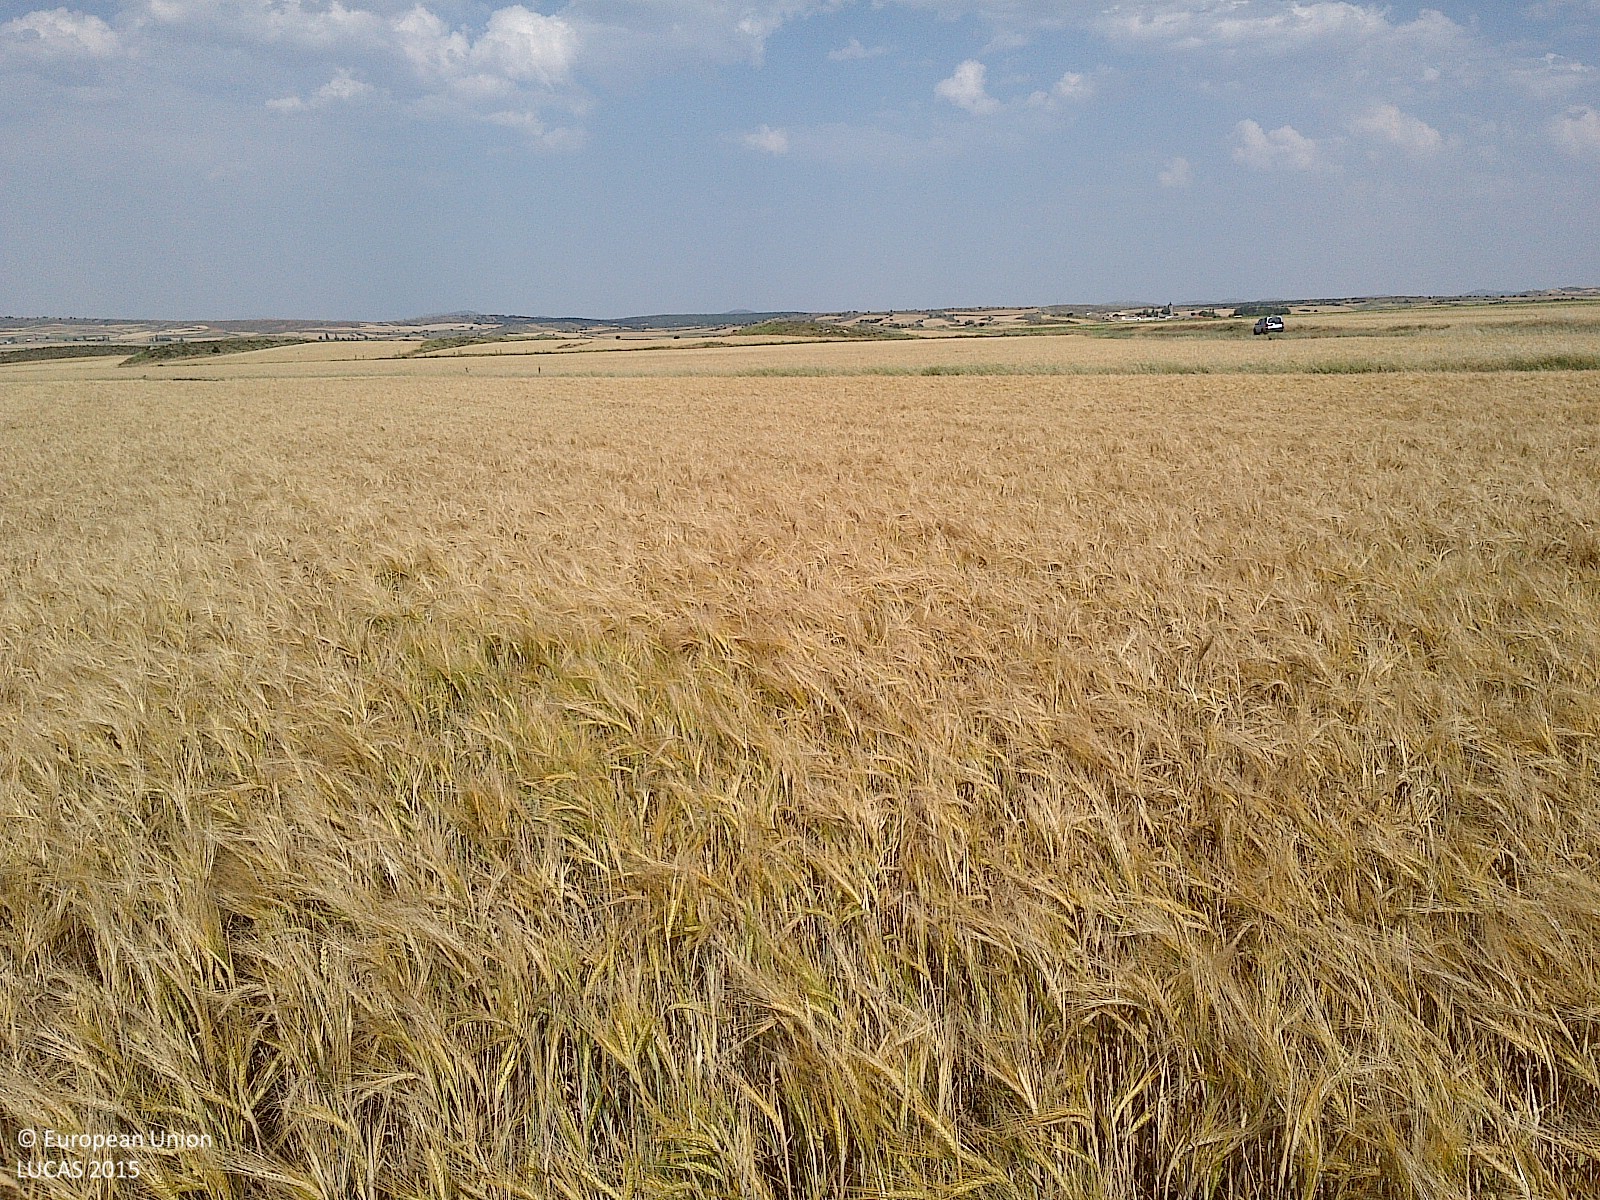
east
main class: Cropland
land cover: Barley
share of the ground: > 75 %
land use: Agriculture (excluding fallow land and kitchen gardens)
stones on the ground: < 10 %
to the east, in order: Barley; Grass margins; Barley
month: June
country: ES
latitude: 41.5783
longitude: -2.2555
